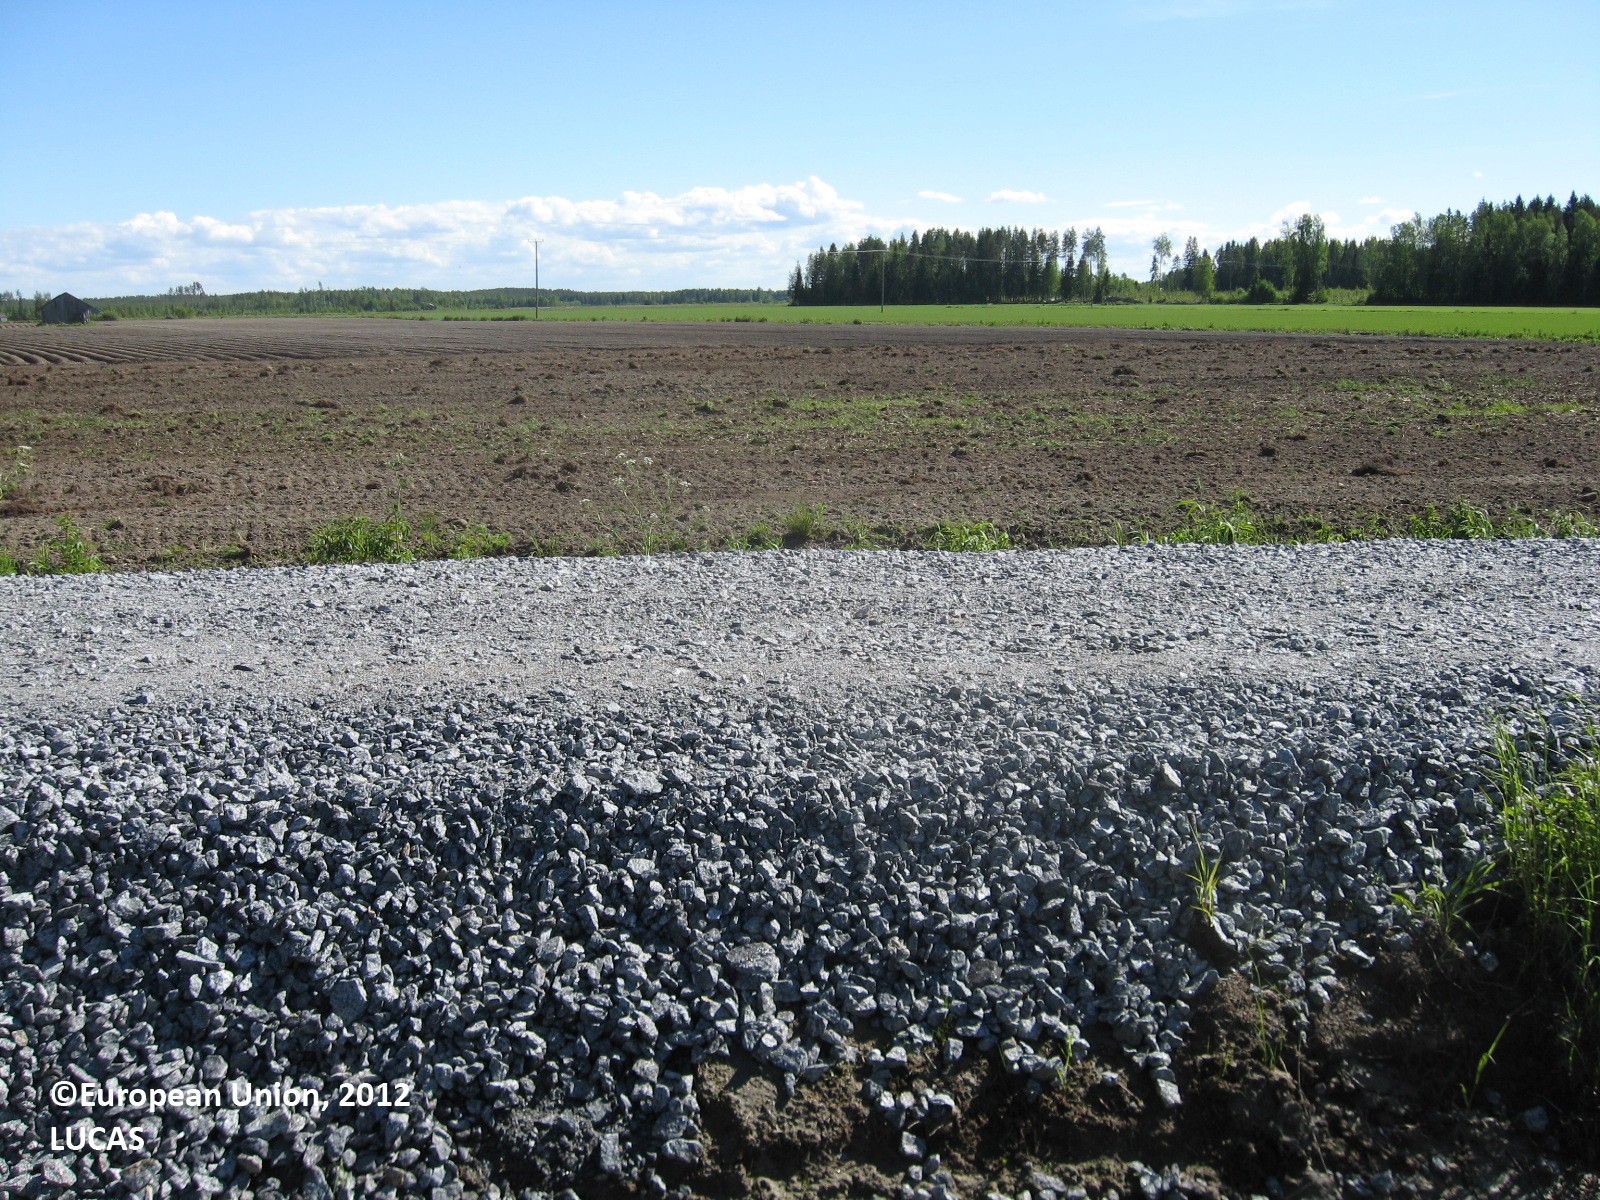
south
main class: Grassland
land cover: Grassland without tree/shrub cover
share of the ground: > 75 %
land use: Agriculture (excluding fallow land and kitchen gardens)
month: June
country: FI
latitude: 63.2942
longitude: 22.7573
